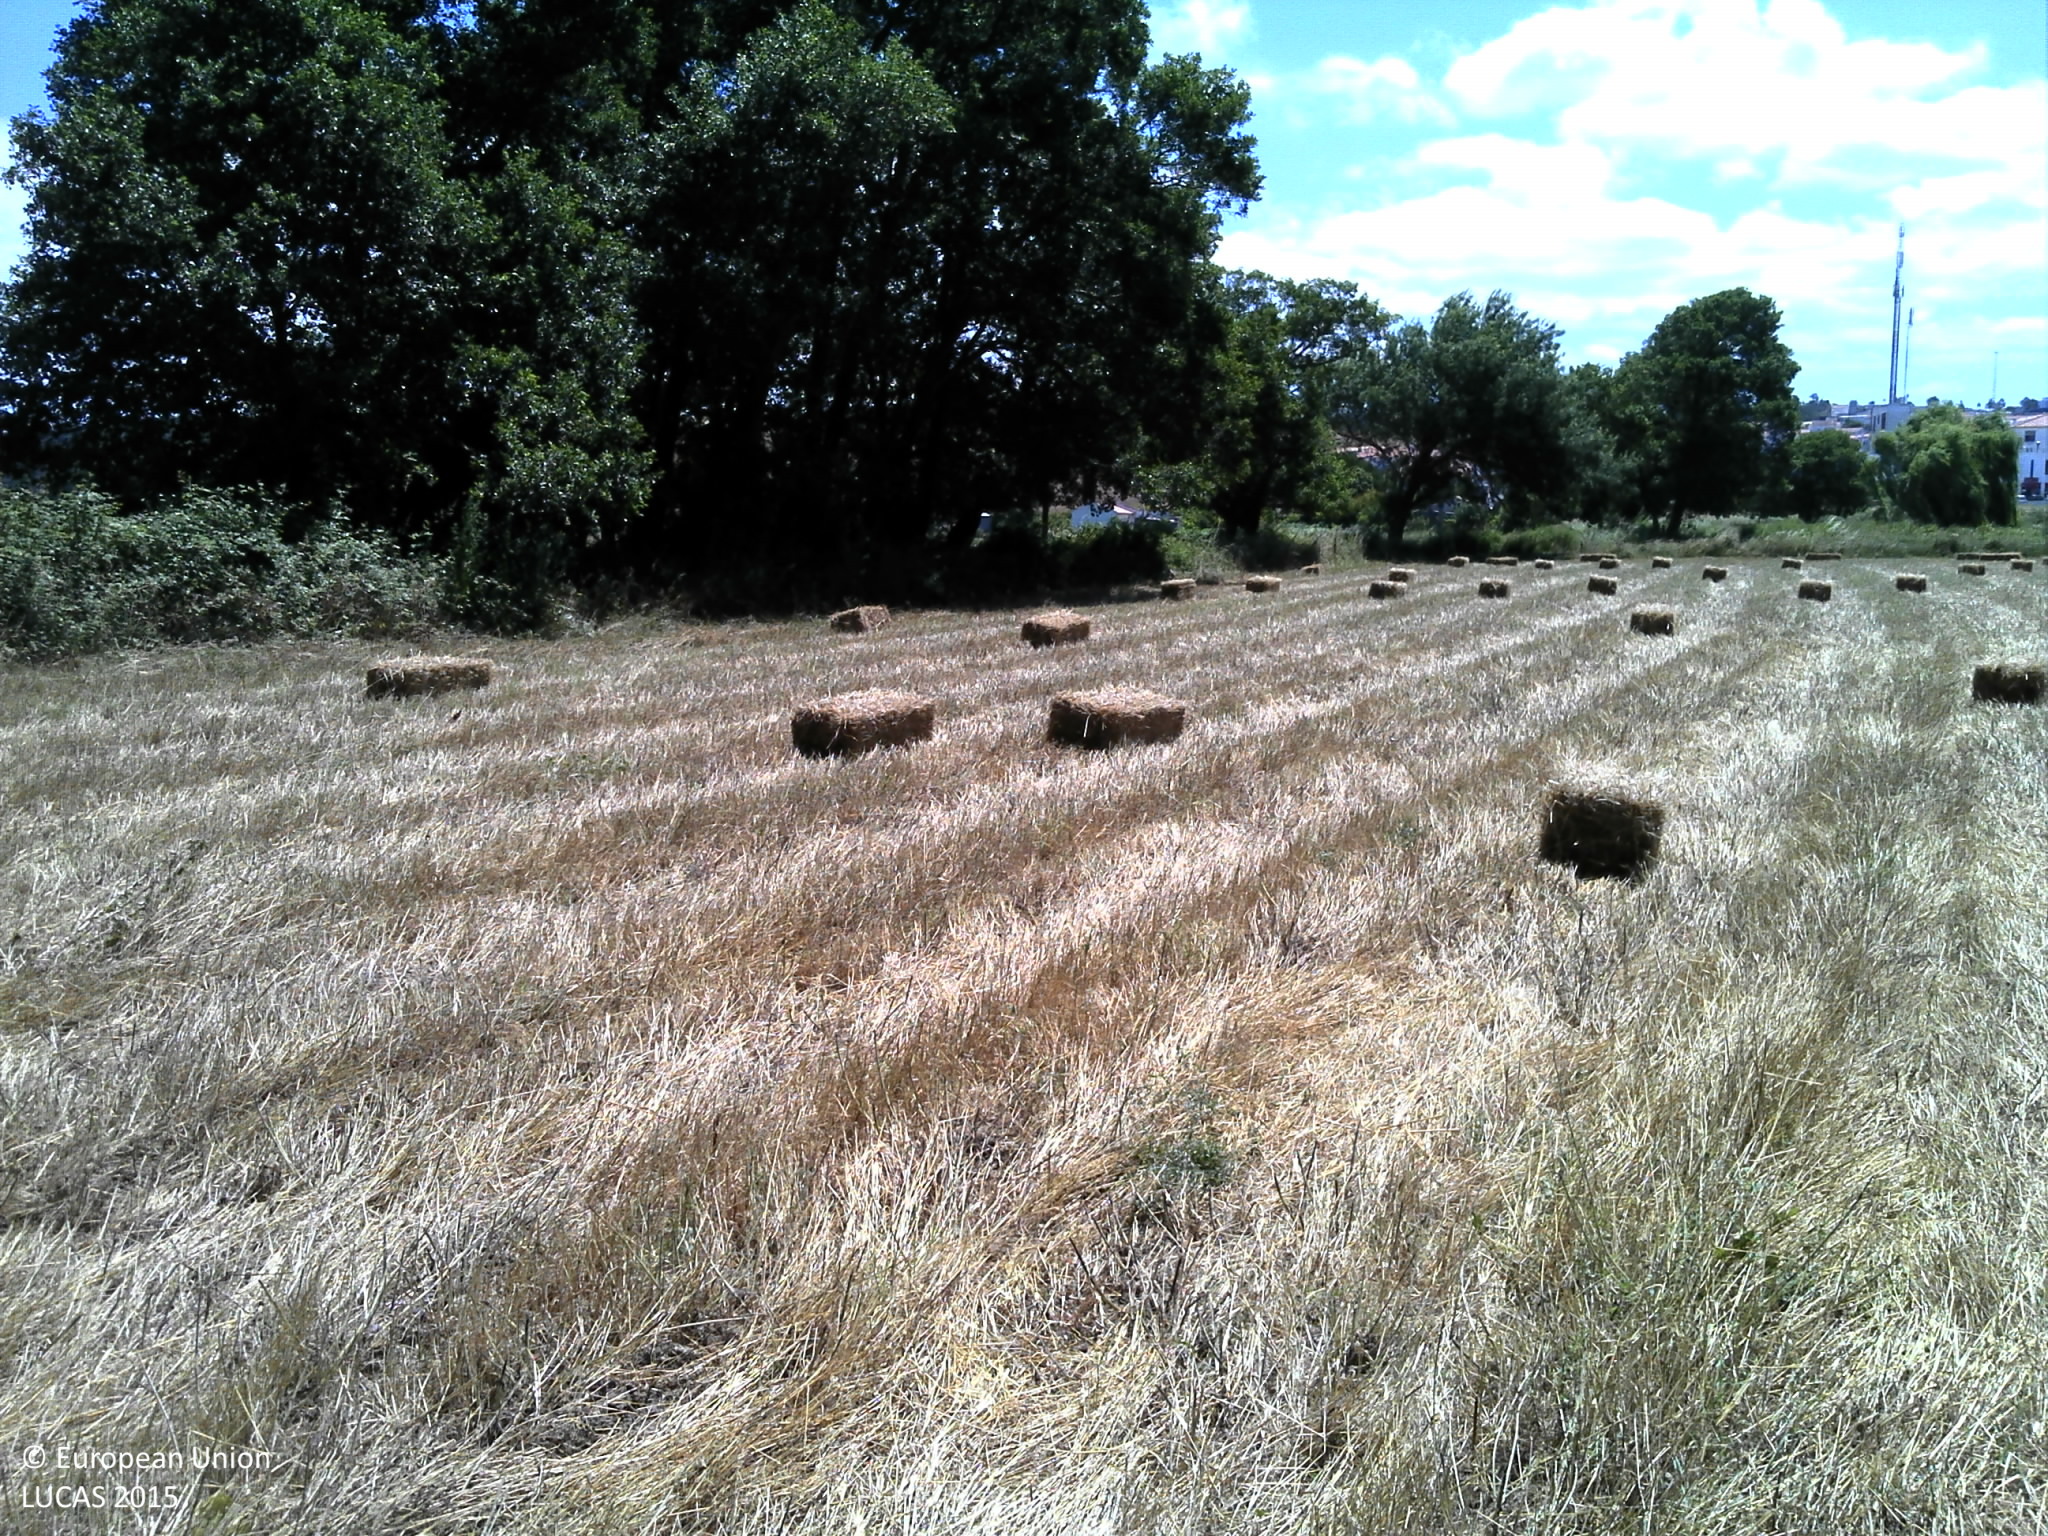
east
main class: Cropland
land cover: Durum wheat
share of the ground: 25 - 50 %
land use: Agriculture (excluding fallow land and kitchen gardens)
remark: Harvested field
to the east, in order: Durum wheat; Abandoned hedges; Rivers and streams; Spontaneously vegetated surfaces; Fences; Spontaneously vegetated surfaces; Electric lines; Spontaneously vegetated surfaces; Fences; Tracks; Maize
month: June
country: PT
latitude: 37.3191
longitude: -8.8020
